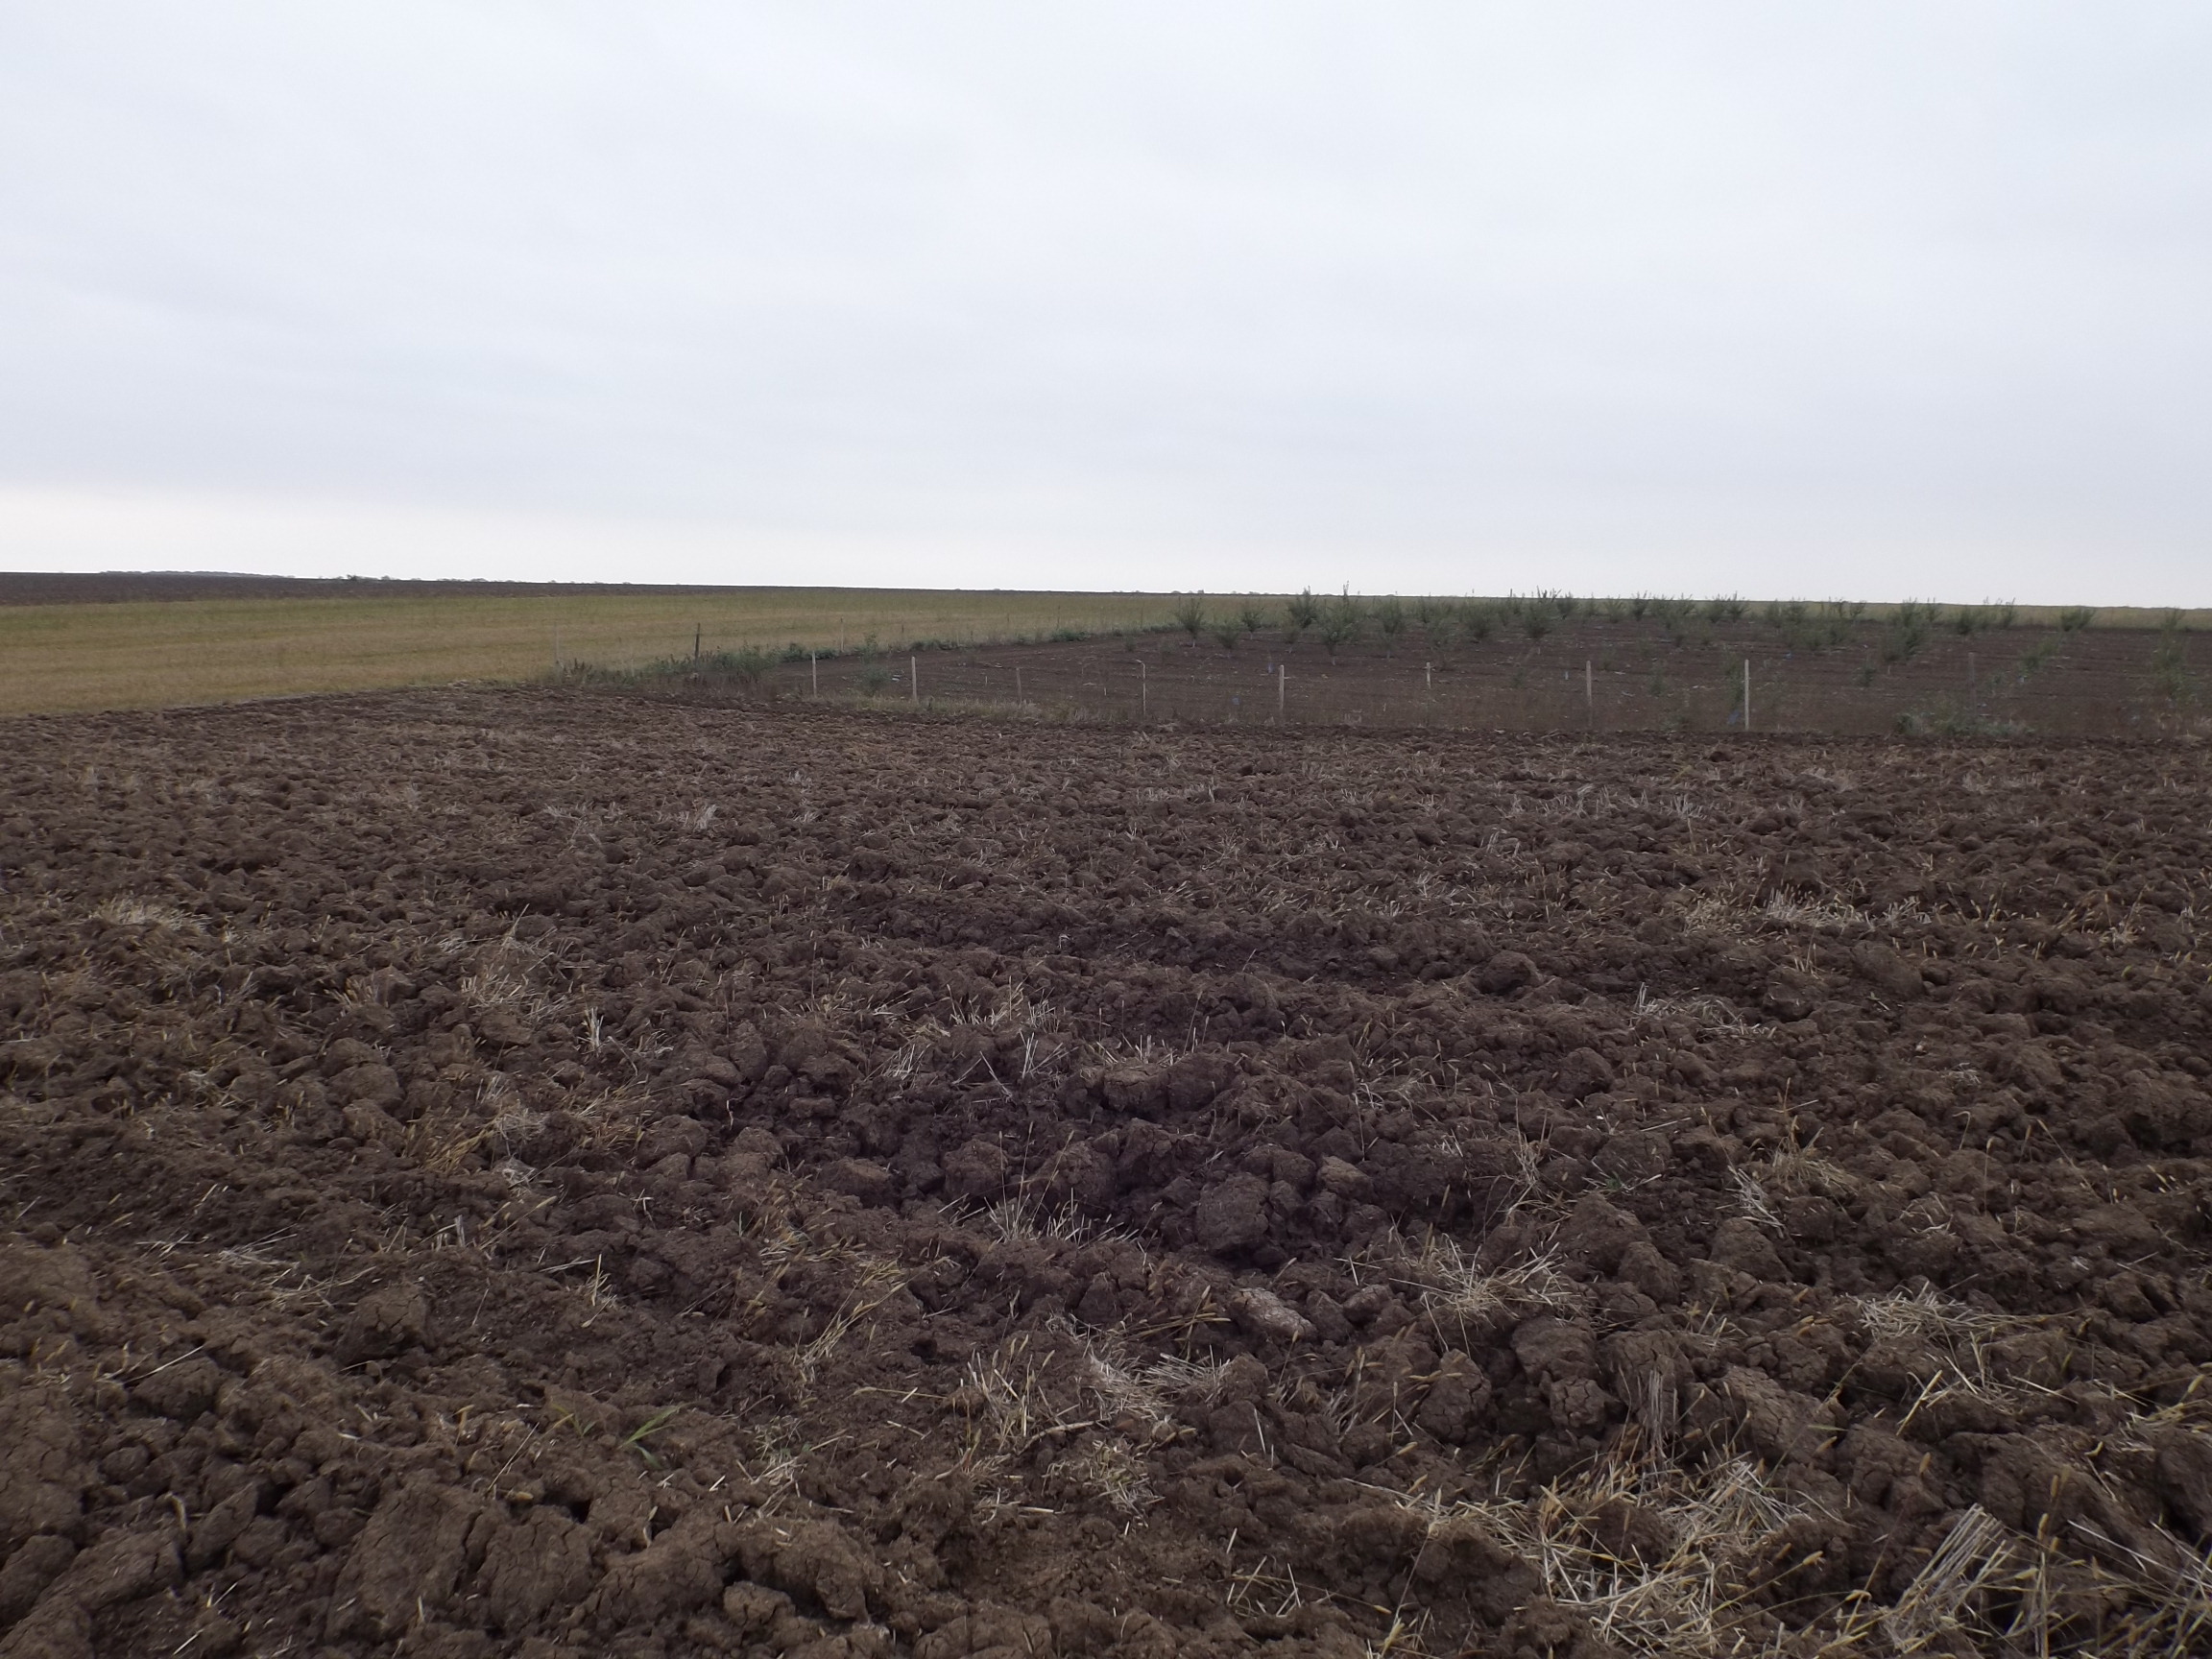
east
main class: Cropland
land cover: Common wheat
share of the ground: < 10 %
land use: Agriculture (excluding fallow land and kitchen gardens)
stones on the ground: < 10 %
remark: Harvested field
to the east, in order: Common wheat; Grass margins; Fences; Other fruit trees and berries; Fences; Grass margins; Common wheat
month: October
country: BG
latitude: 43.9502
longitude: 26.6485
